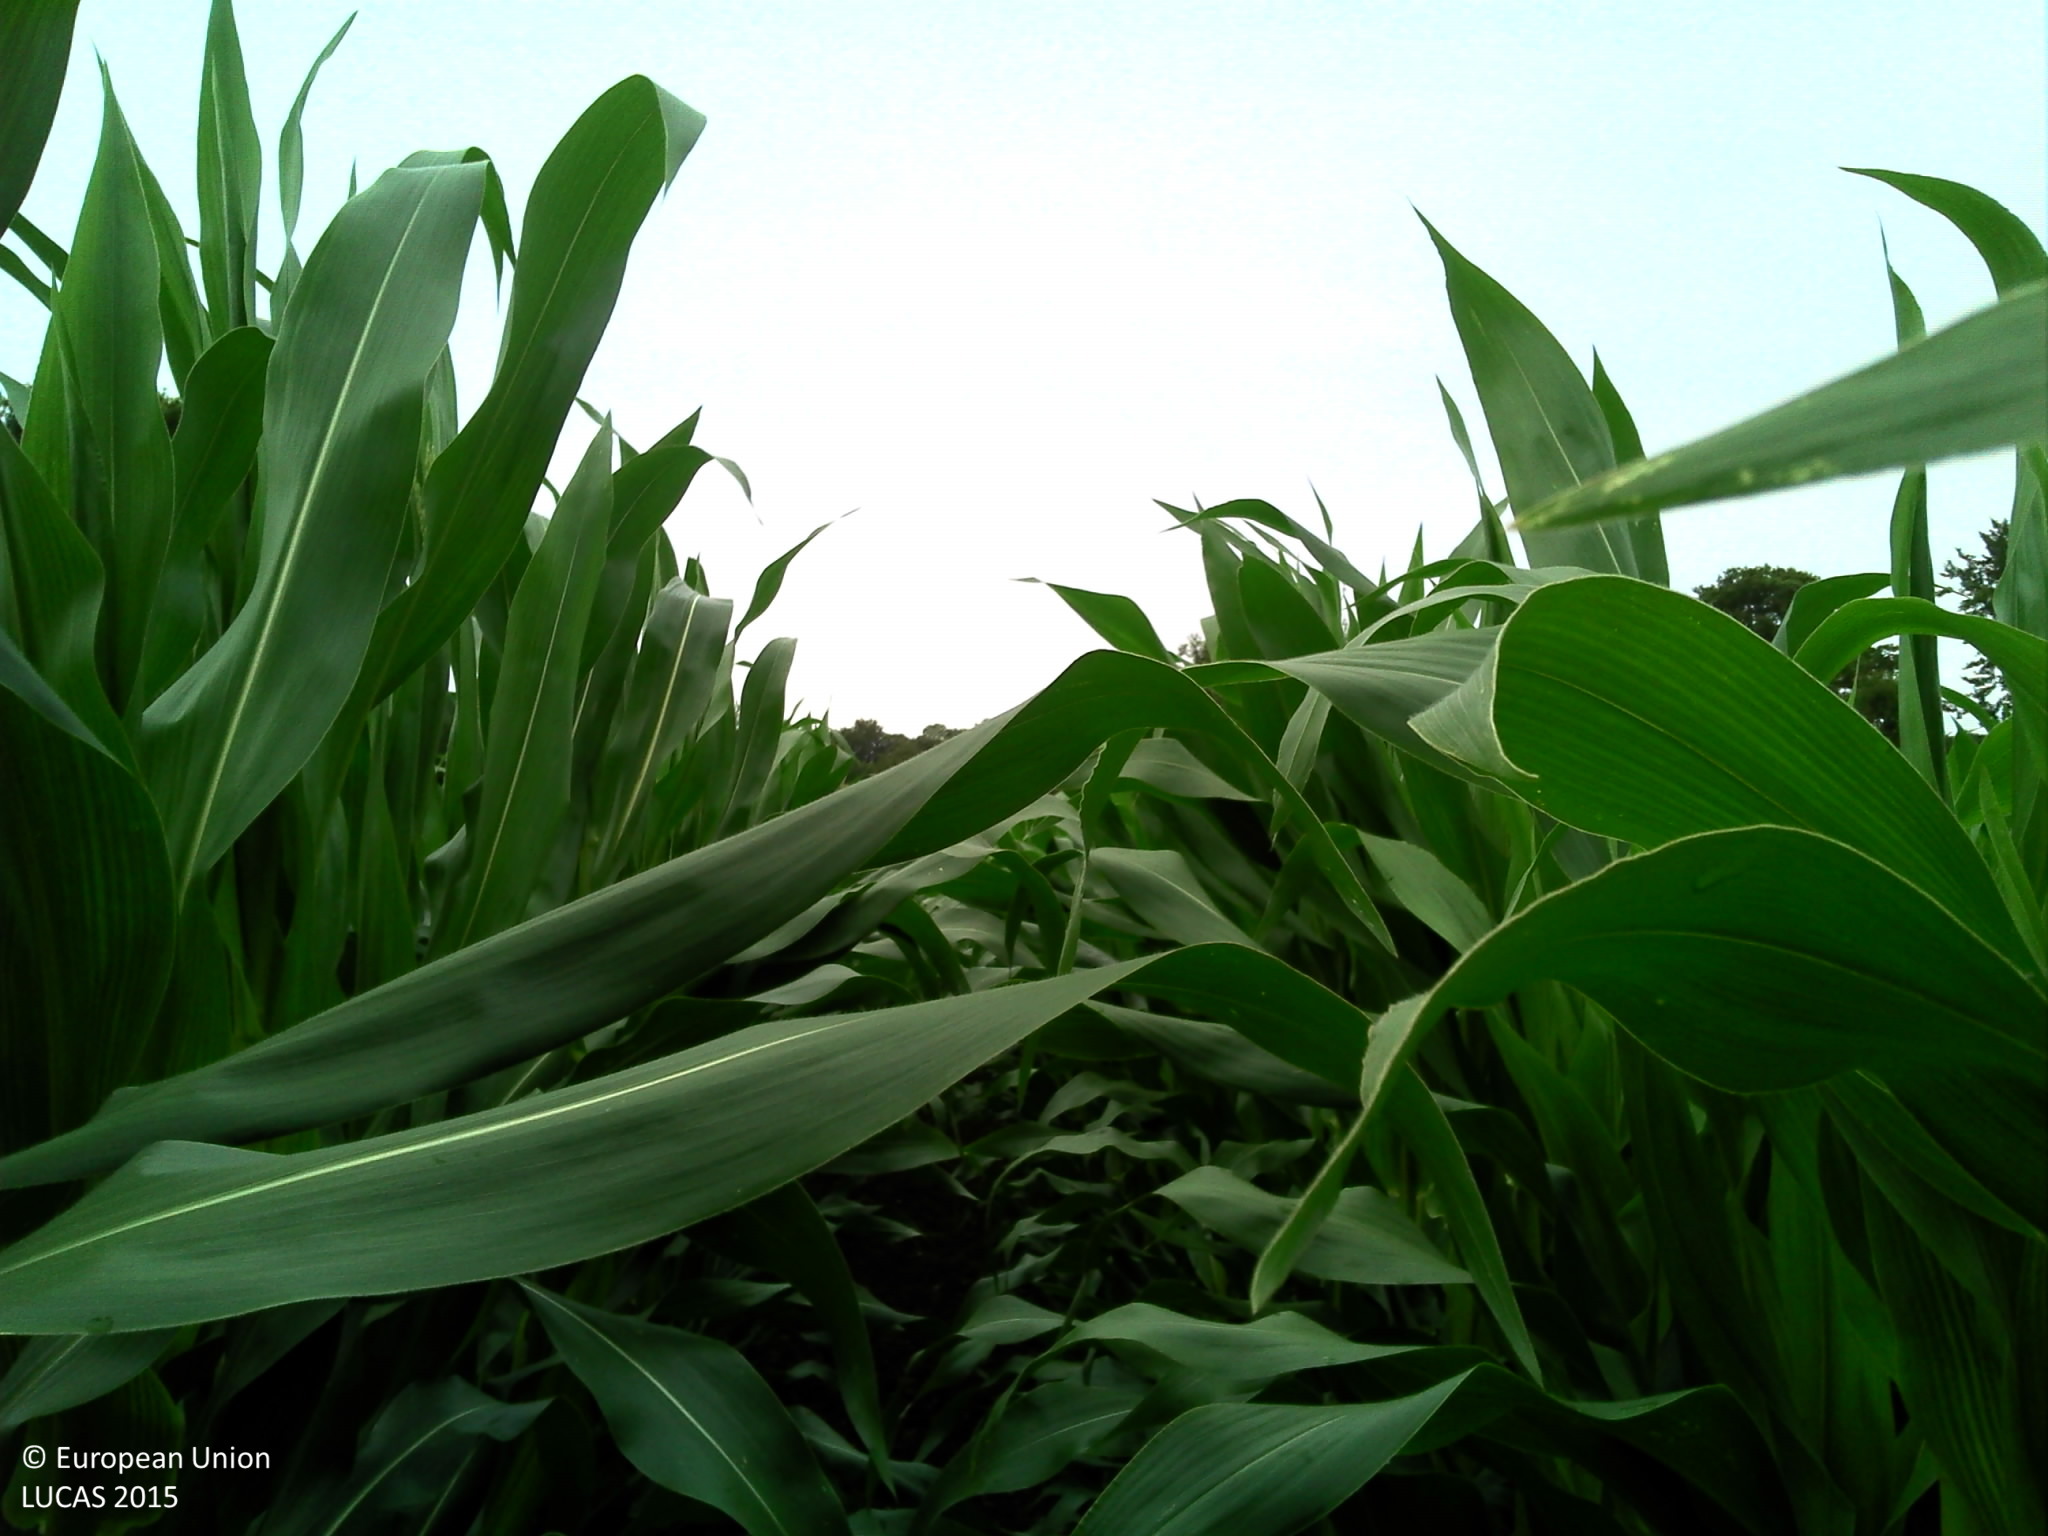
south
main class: Cropland
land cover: Maize
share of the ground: 50 - 75 %
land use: Agriculture (excluding fallow land and kitchen gardens)
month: July
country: FR
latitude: 48.2294
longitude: -3.0336
